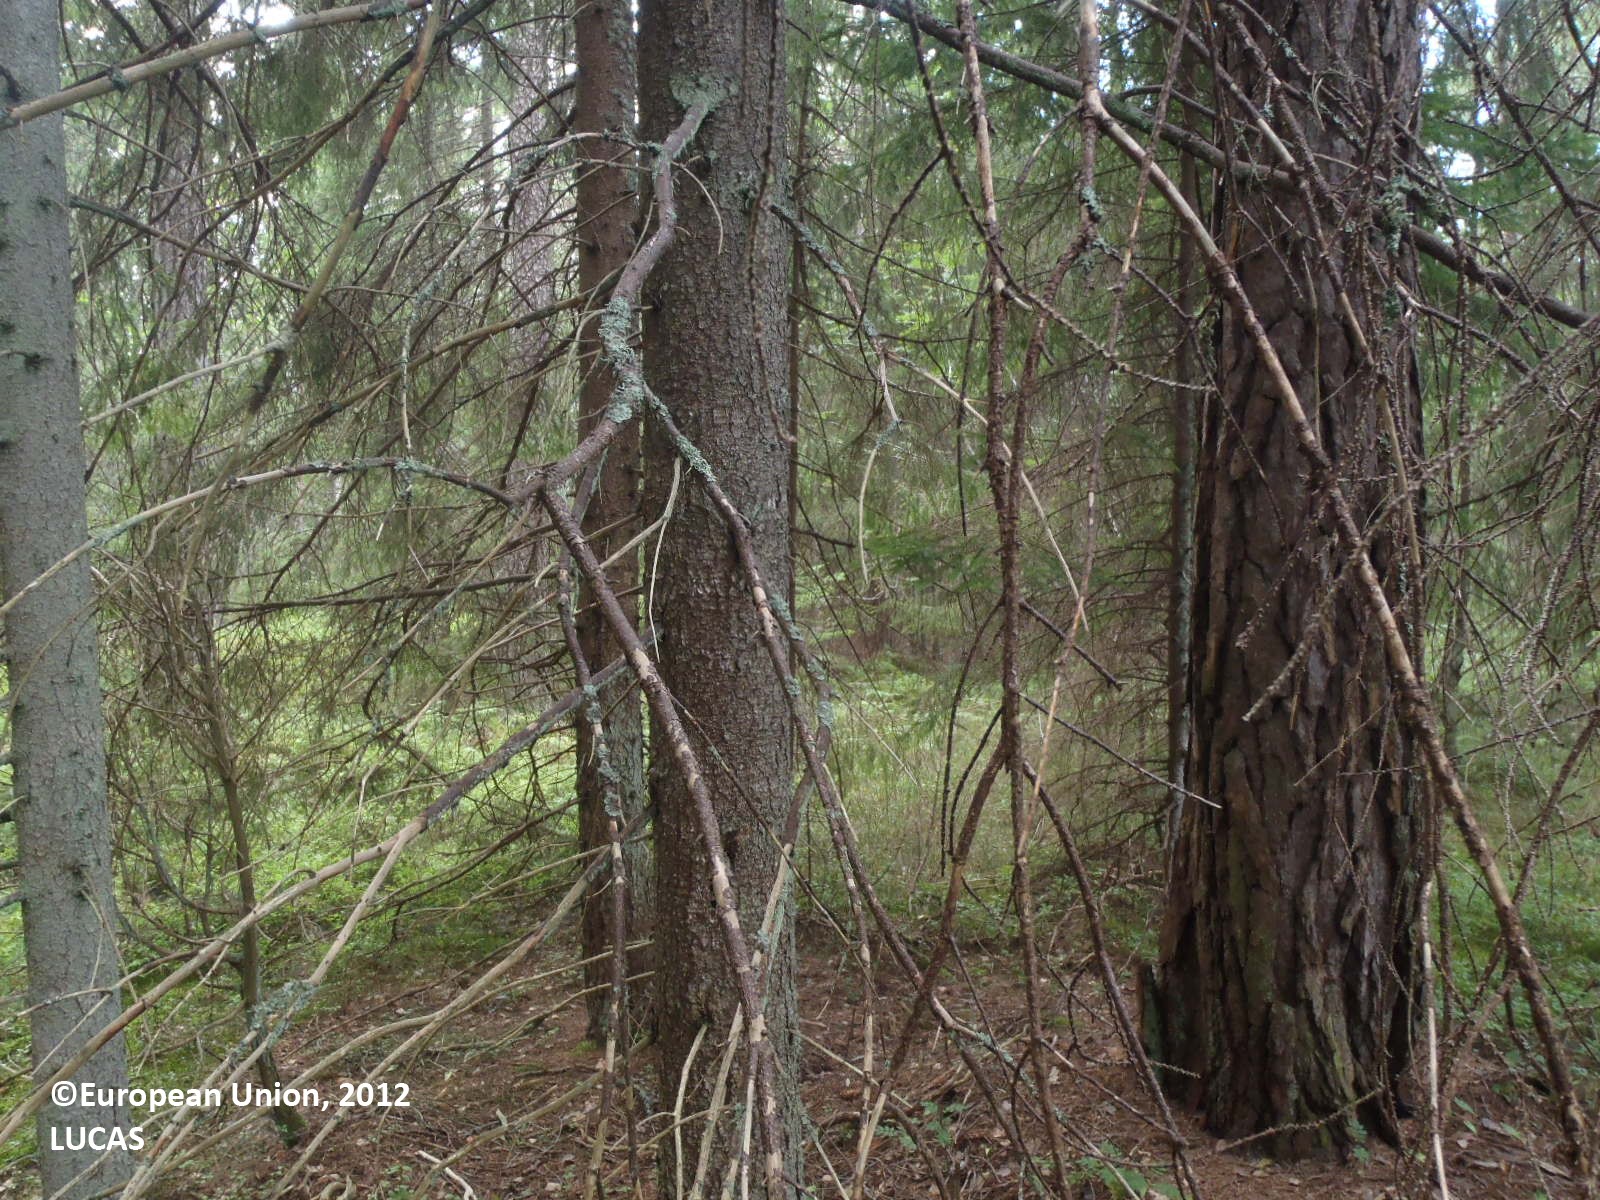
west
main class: Woodland
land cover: Pine dominated coniferous woodland
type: hemiboreal forest and nemoral coniferous forest and mixed broadleaved-coniferous forest
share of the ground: > 75 %
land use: Forestry
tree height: > 5 m
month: August
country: FI
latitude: 60.2631
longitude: 19.9648
